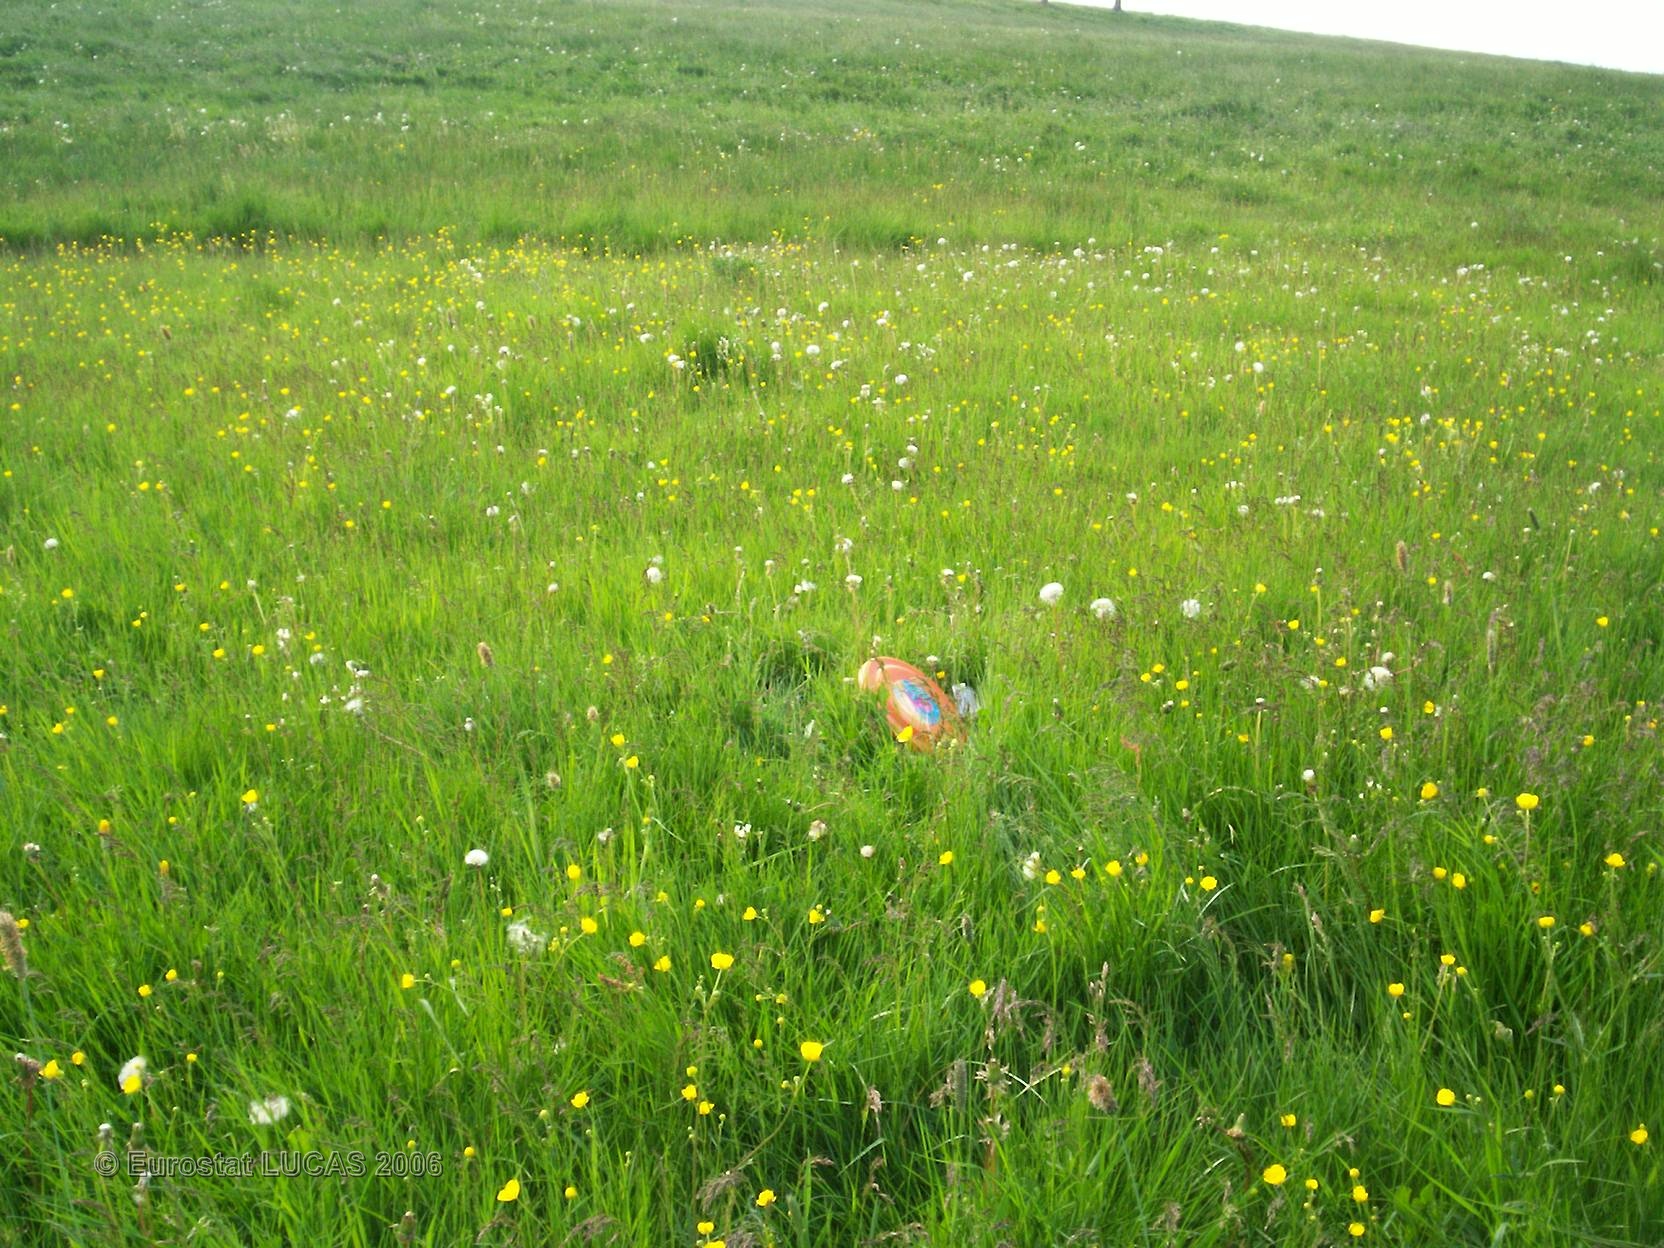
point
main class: Grassland
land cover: Grassland without tree/shrub cover
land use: Agriculture (excluding fallow land and kitchen gardens)
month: May
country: FR
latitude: 44.7013
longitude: 3.4038
